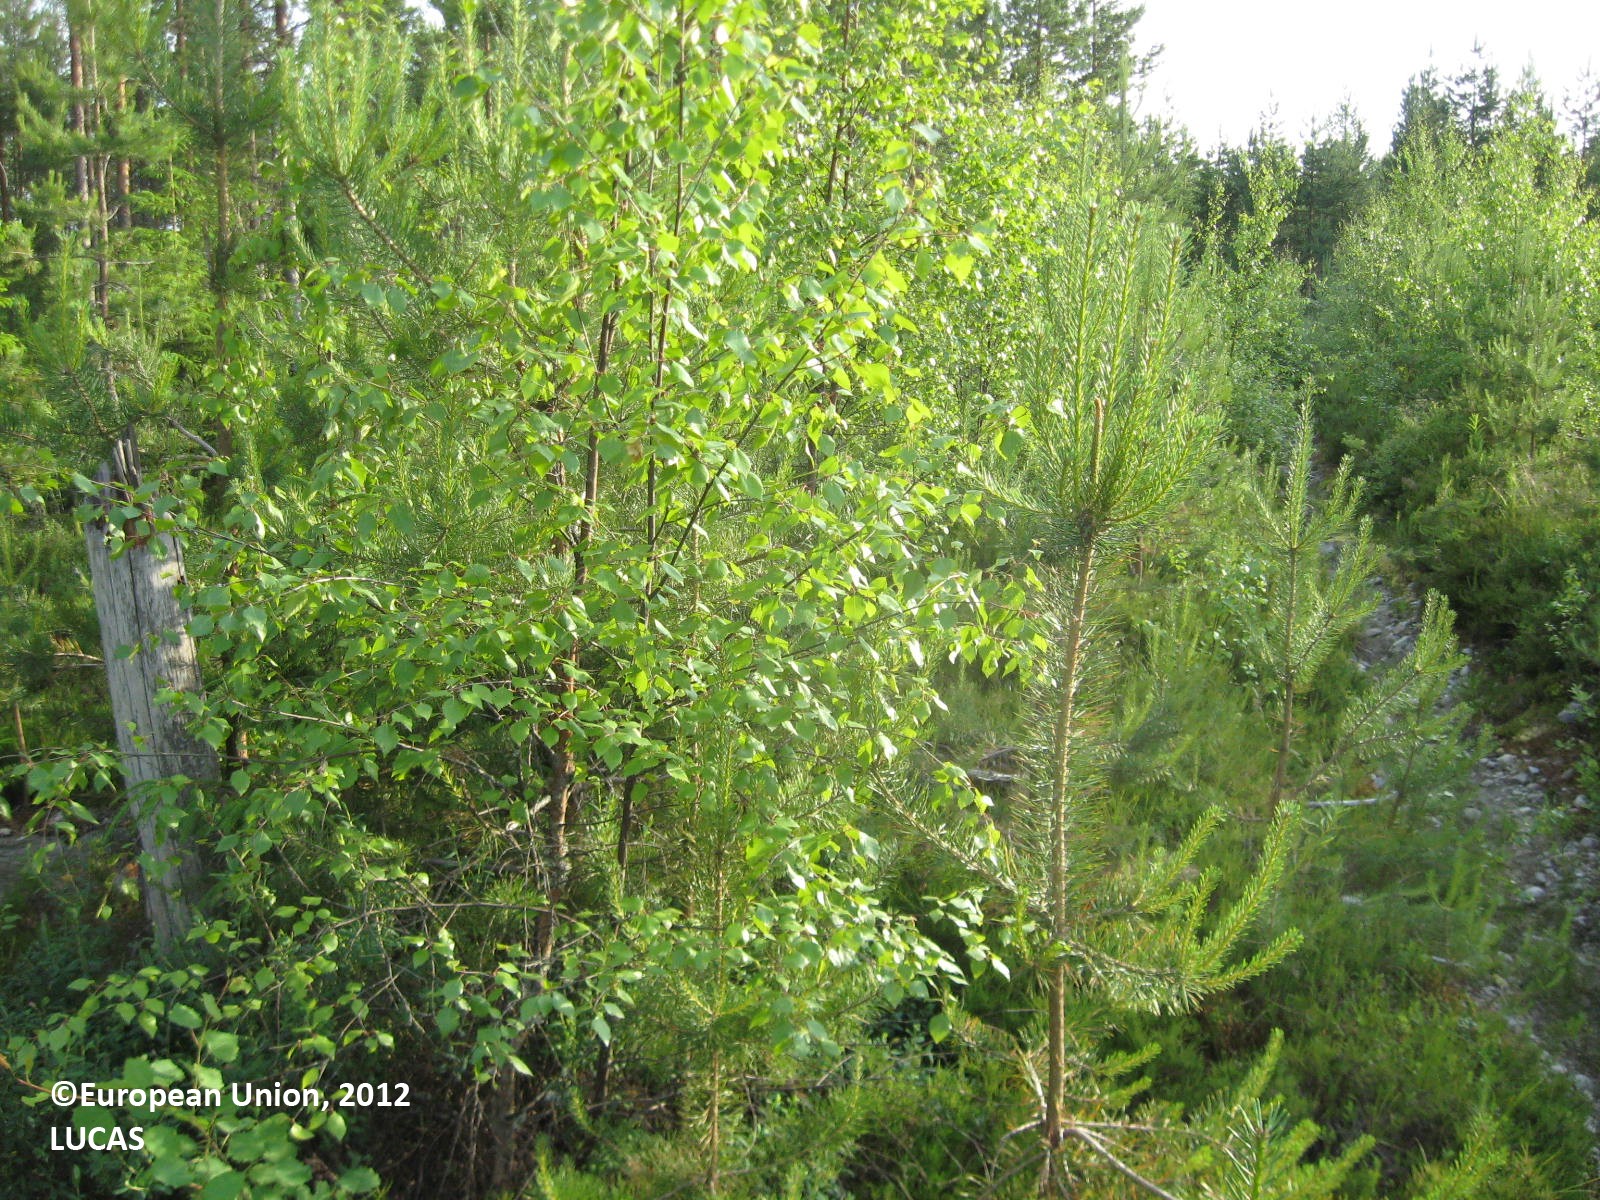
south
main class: Woodland
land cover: Pine dominated mixed woodland
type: boreal forest
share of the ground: > 75 %
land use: Forestry
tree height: < 5 m
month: July
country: FI
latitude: 62.5538
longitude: 21.7336
